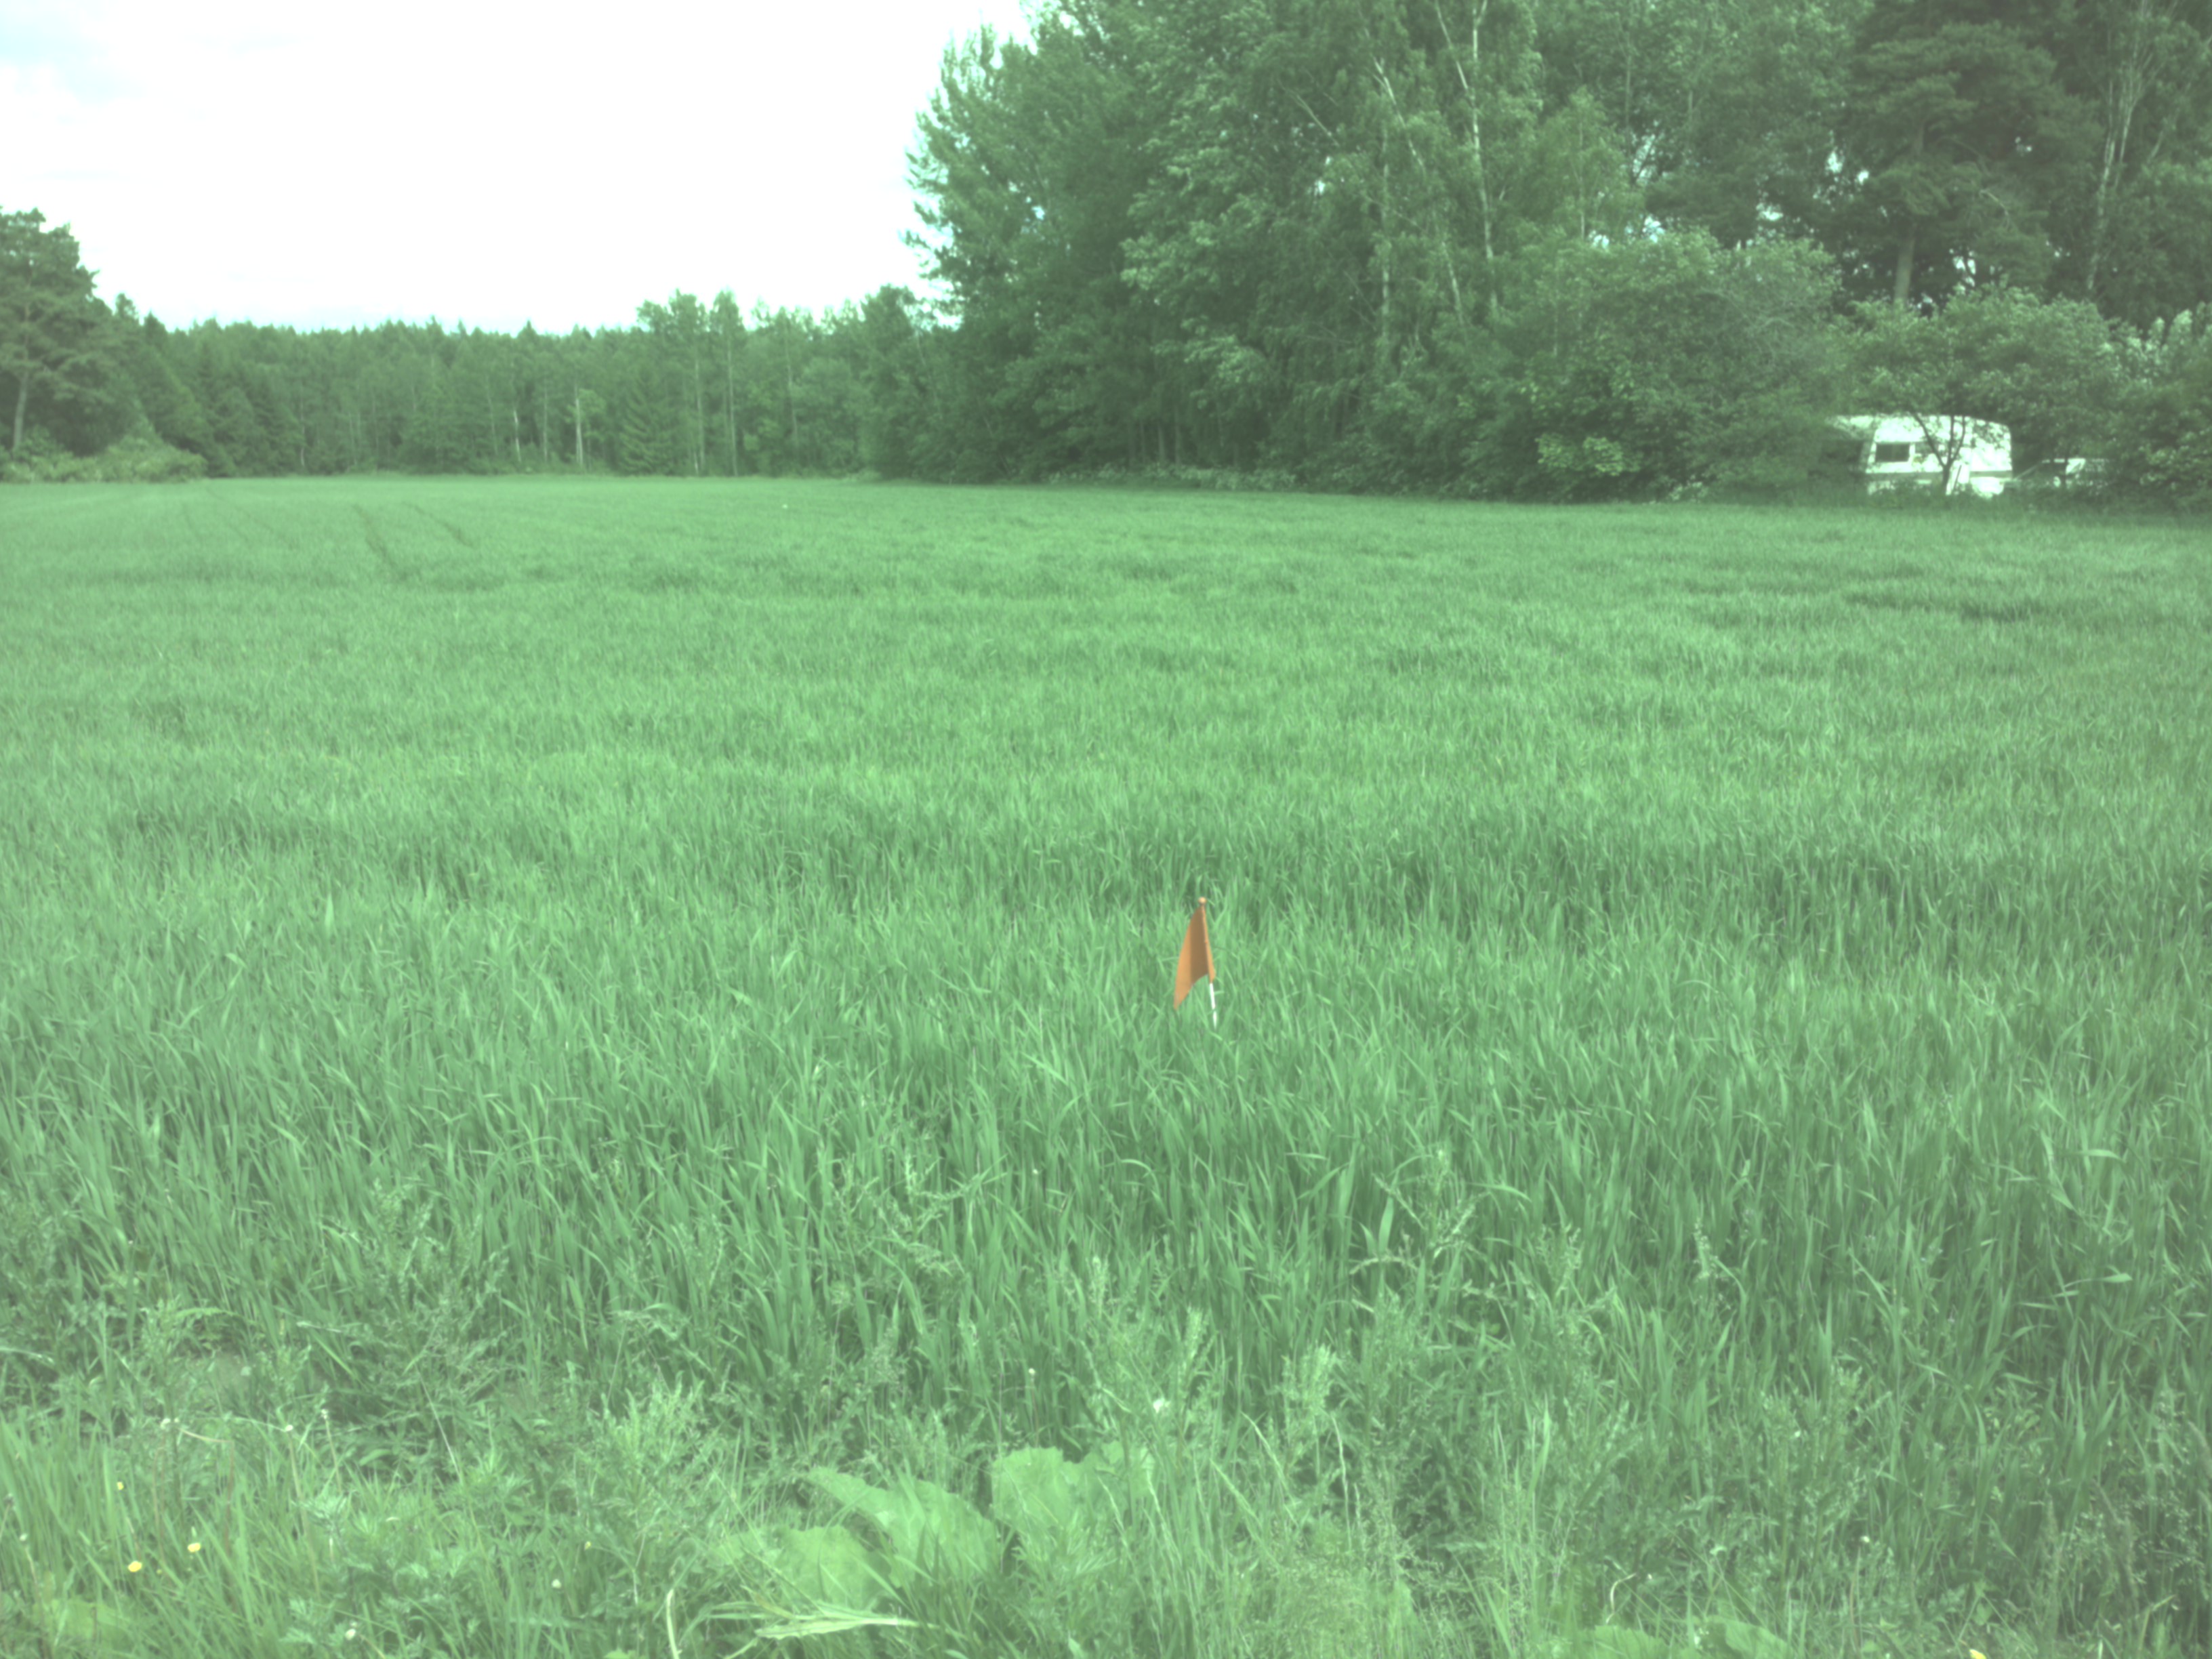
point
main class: Cropland
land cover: Oats
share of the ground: > 75 %
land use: Agriculture (excluding fallow land and kitchen gardens)
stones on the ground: < 10 %
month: June
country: SE
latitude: 59.4172
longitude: 17.5555
